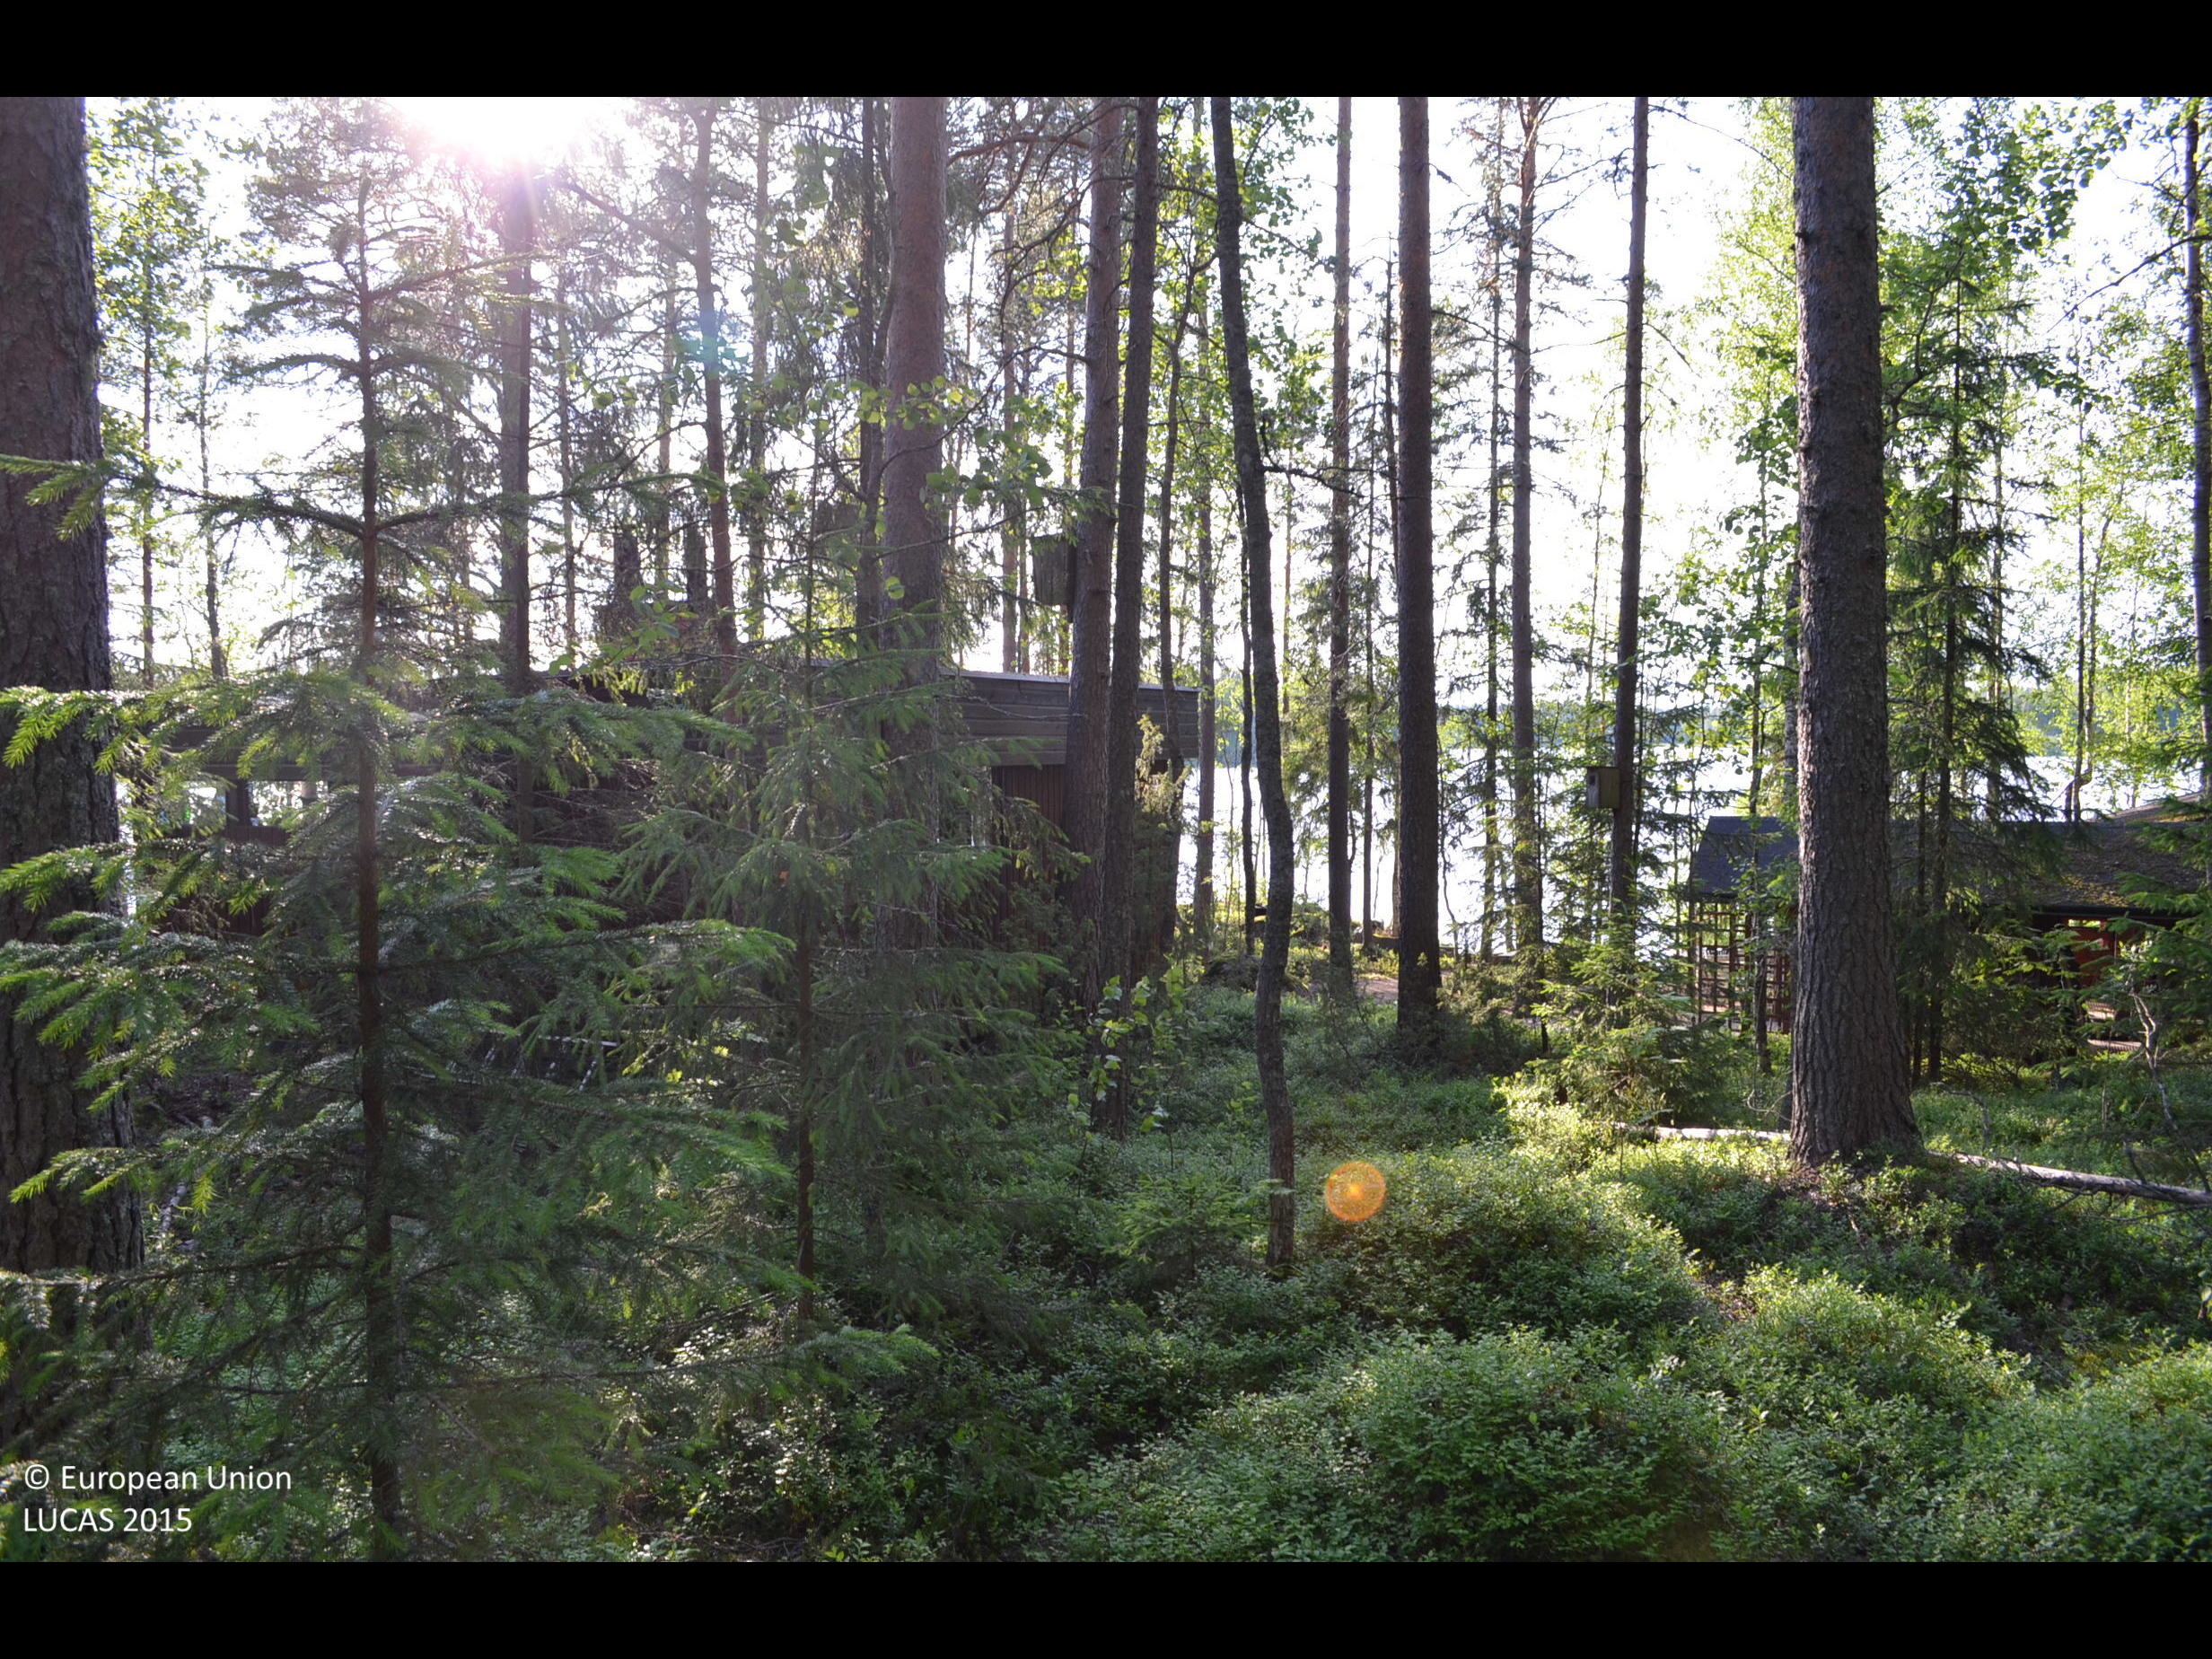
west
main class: Woodland
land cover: Other coniferous woodland
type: boreal forest
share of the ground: > 75 %
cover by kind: coniferous forest trees 60 %, shrubs 20 %, broadleaved forest trees 15 %
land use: Amenities, museums, leisure
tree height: > 5 m
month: July
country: FI
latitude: 61.8632
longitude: 23.3998
